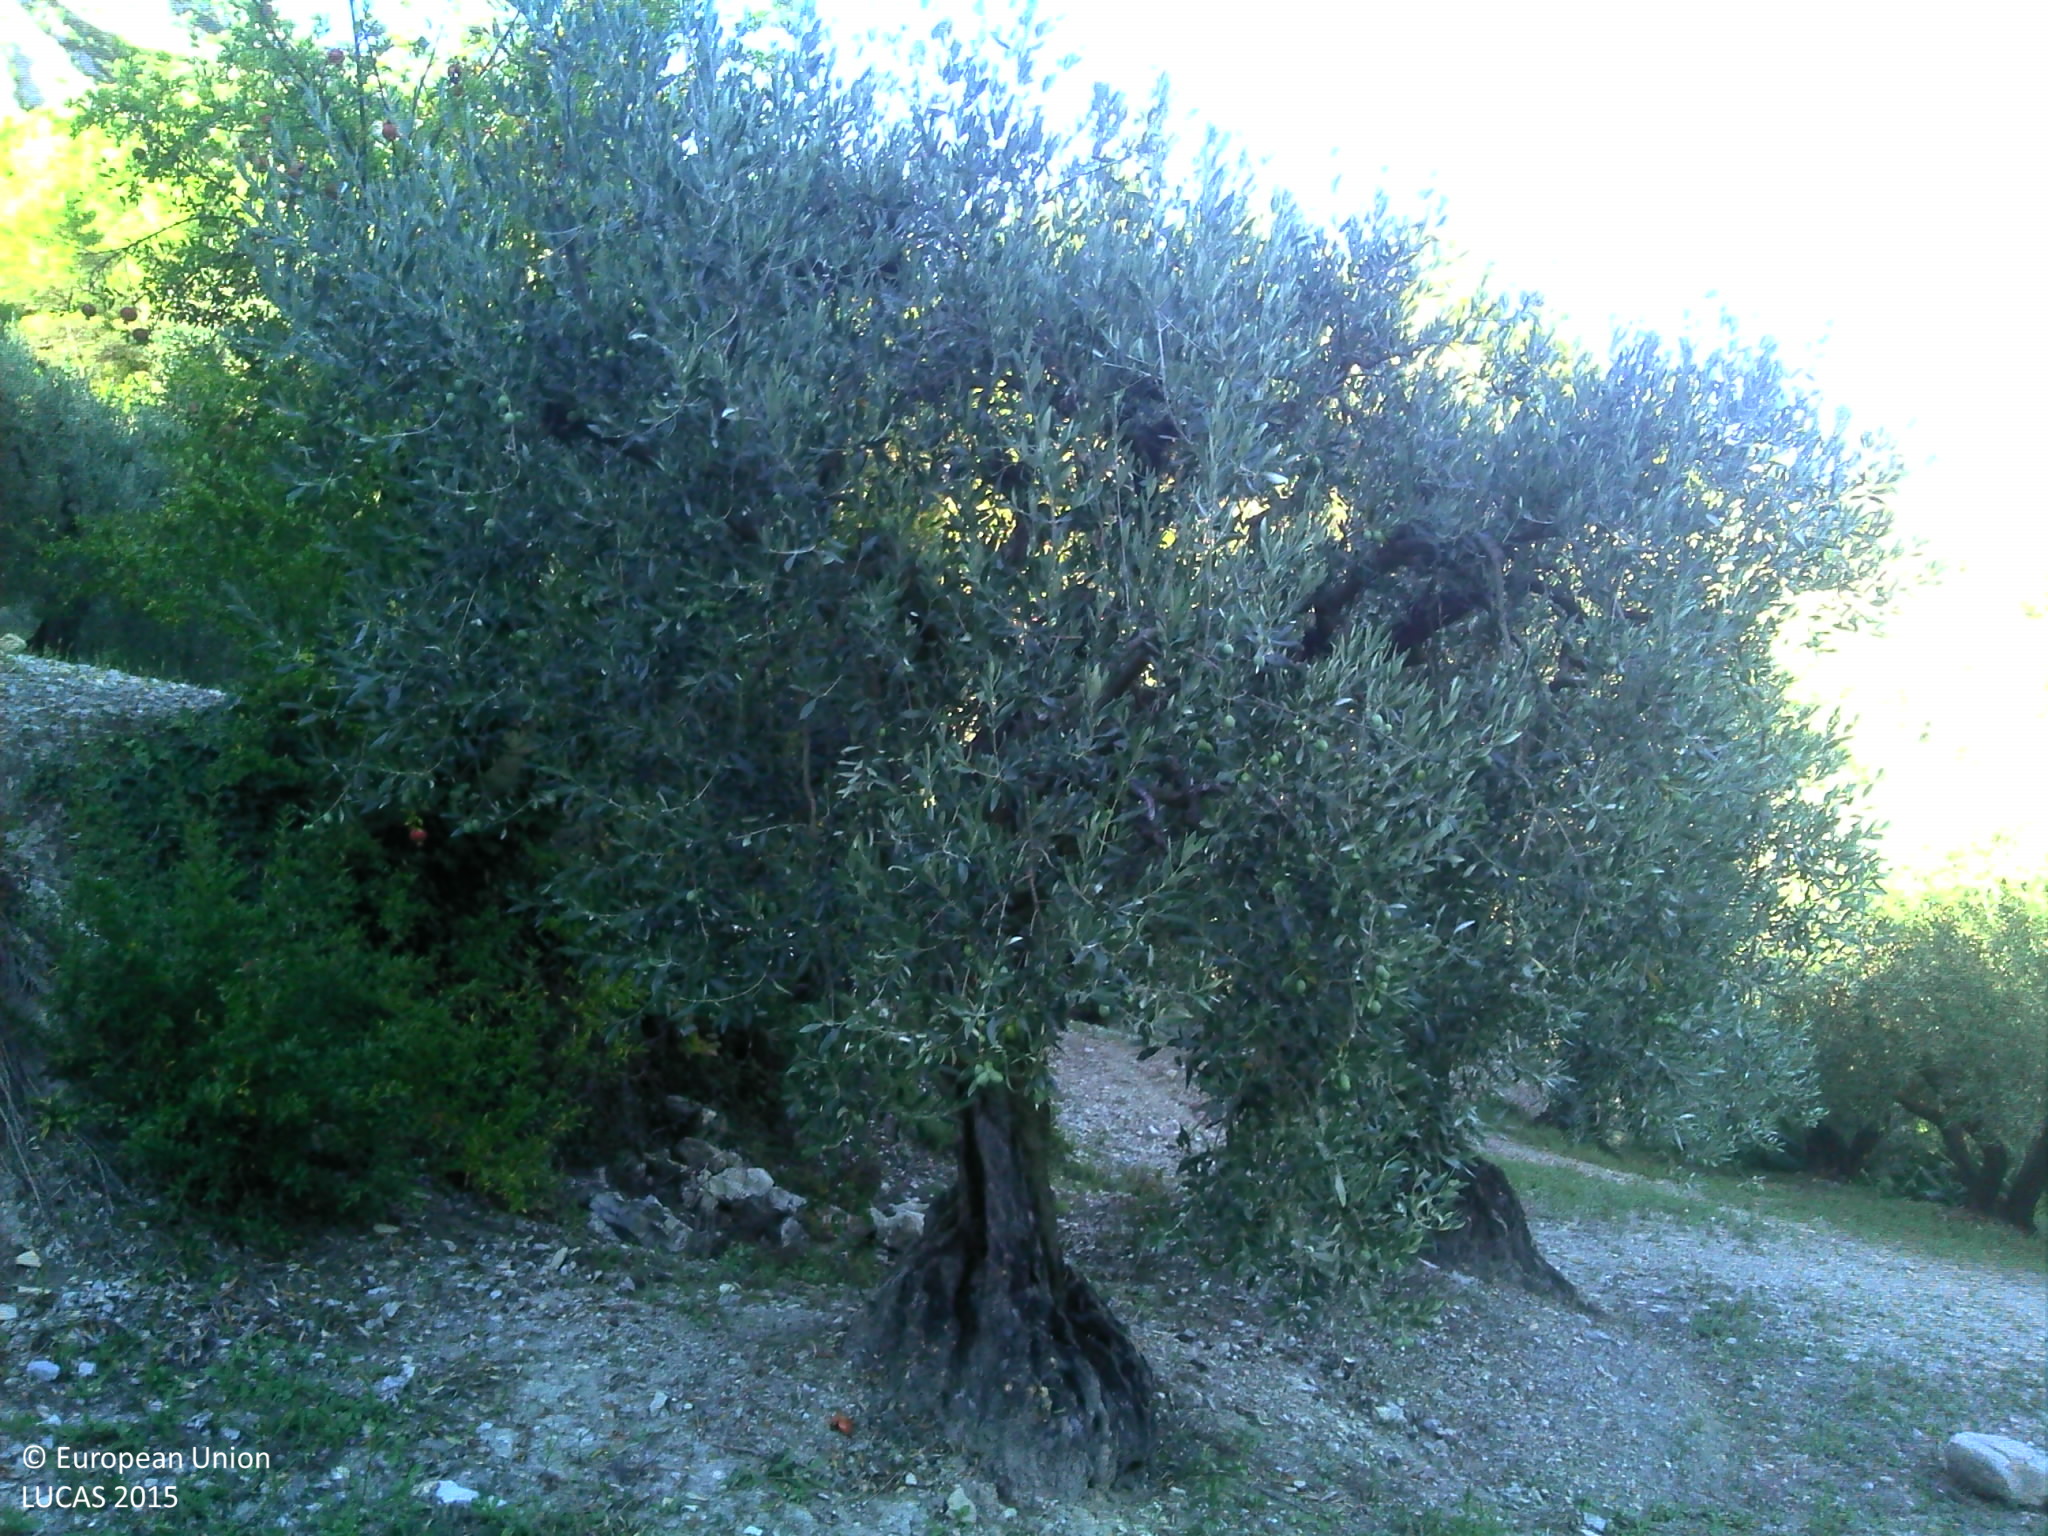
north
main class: Cropland
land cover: Olive groves
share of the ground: > 75 %
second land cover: Rocks and stones
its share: > 75 %
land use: Agriculture (excluding fallow land and kitchen gardens)
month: September
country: FR
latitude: 44.2975
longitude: 5.2824
